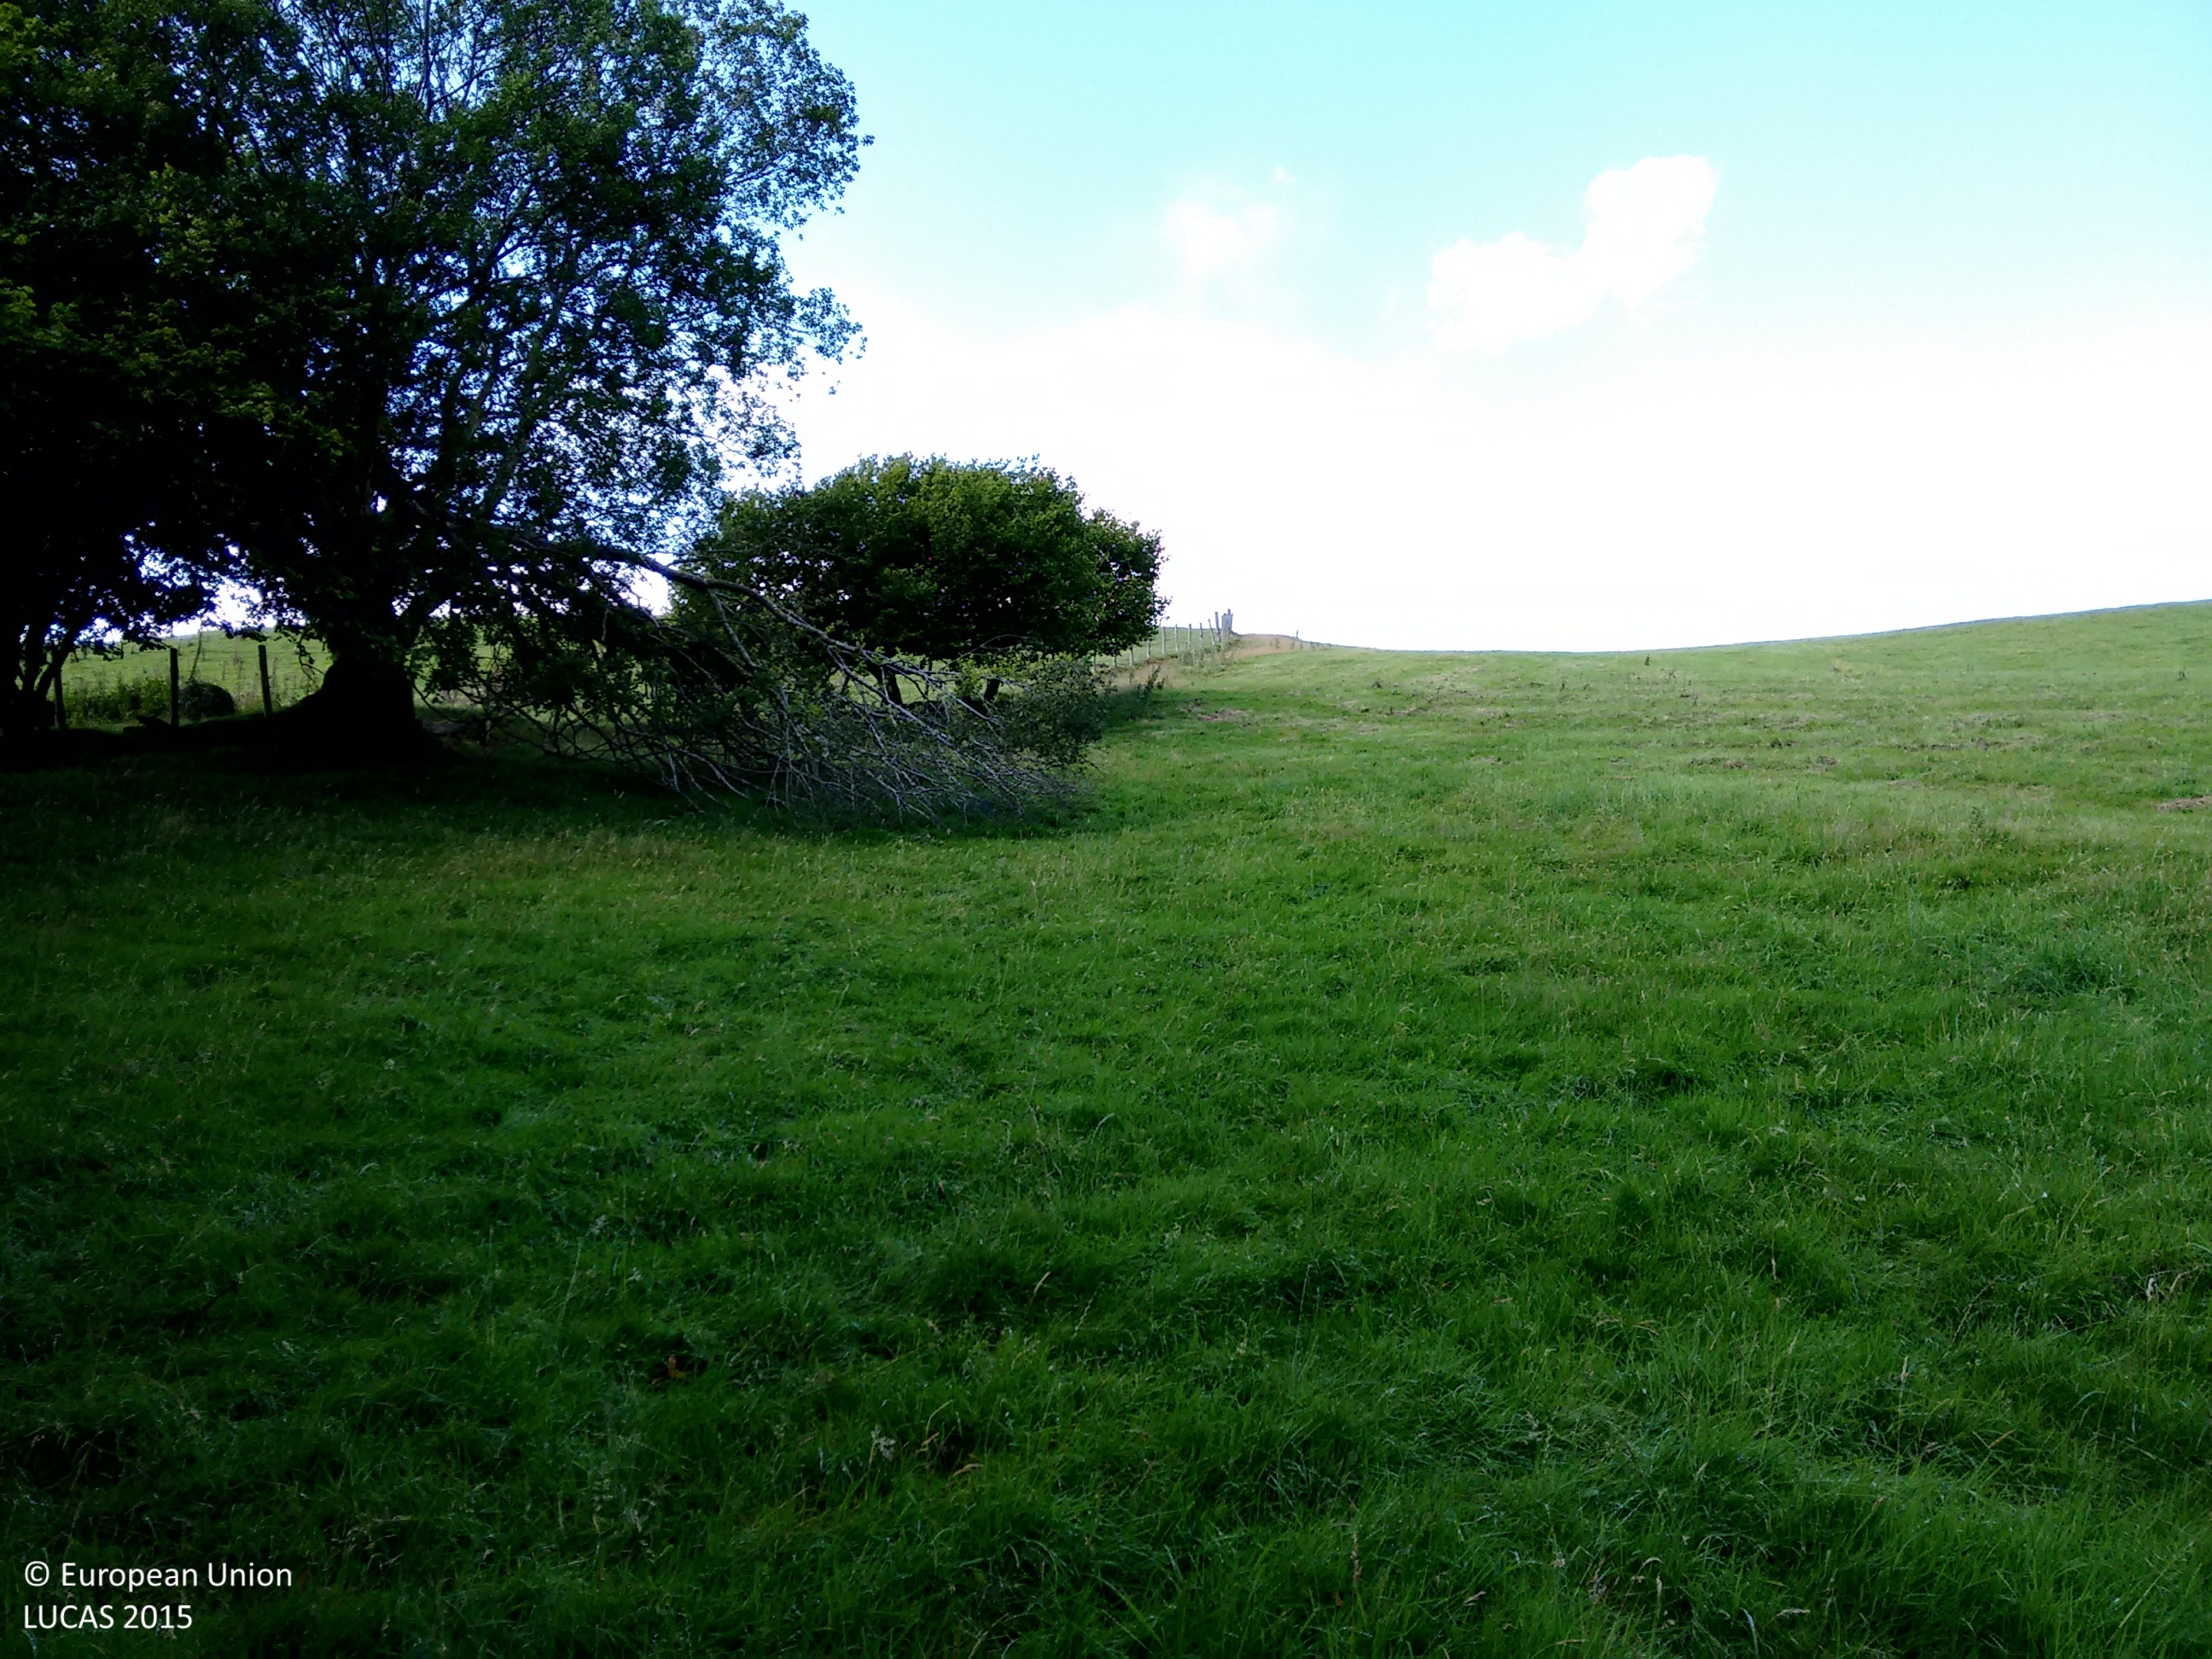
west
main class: Grassland
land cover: Grassland without tree/shrub cover
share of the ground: > 75 %
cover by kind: herbaceous plants 100 %
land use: Agriculture (excluding fallow land and kitchen gardens)
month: August
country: GB
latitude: 53.1634
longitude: -3.5616
